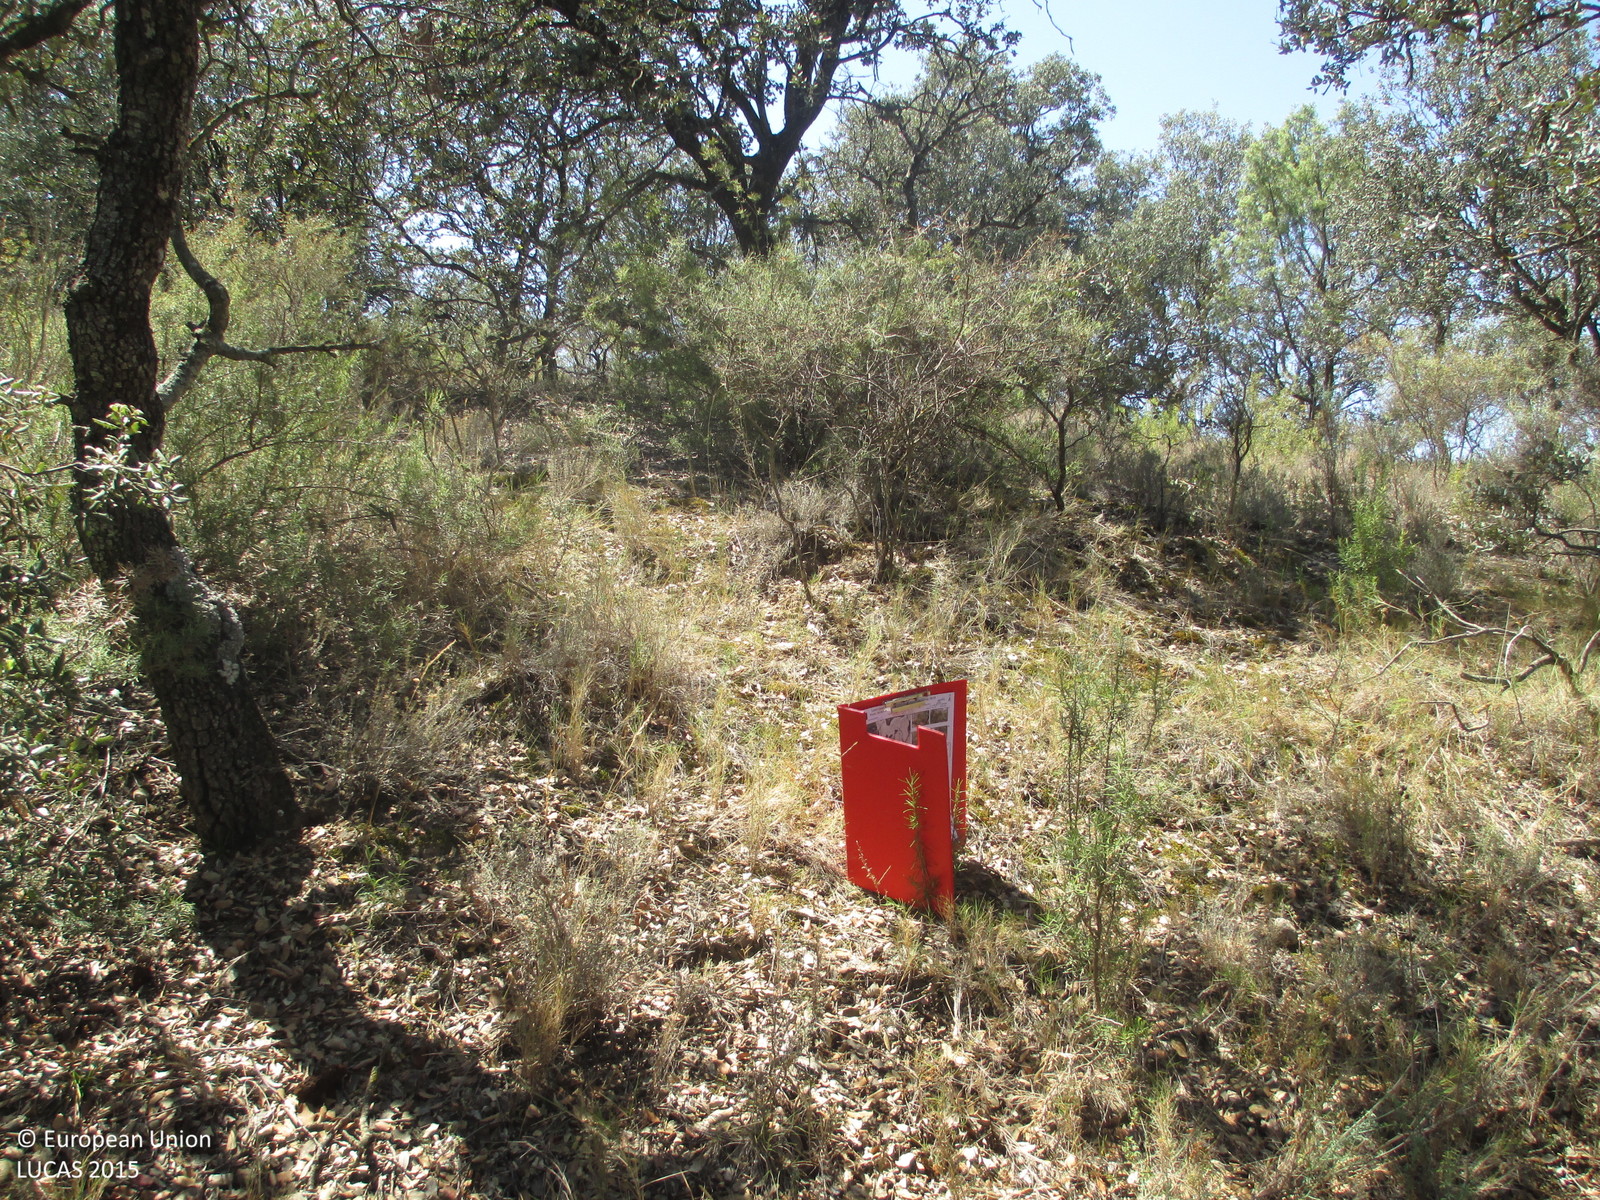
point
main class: Woodland
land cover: Broadleaved woodland
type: broadleaved evergreen forest
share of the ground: > 75 %
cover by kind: broadleaved forest trees 95 %, herbaceous plants 5 %
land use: Semi-natural and natural areas not in use
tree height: < 5 m
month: July
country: ES
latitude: 41.9531
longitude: 0.3203
